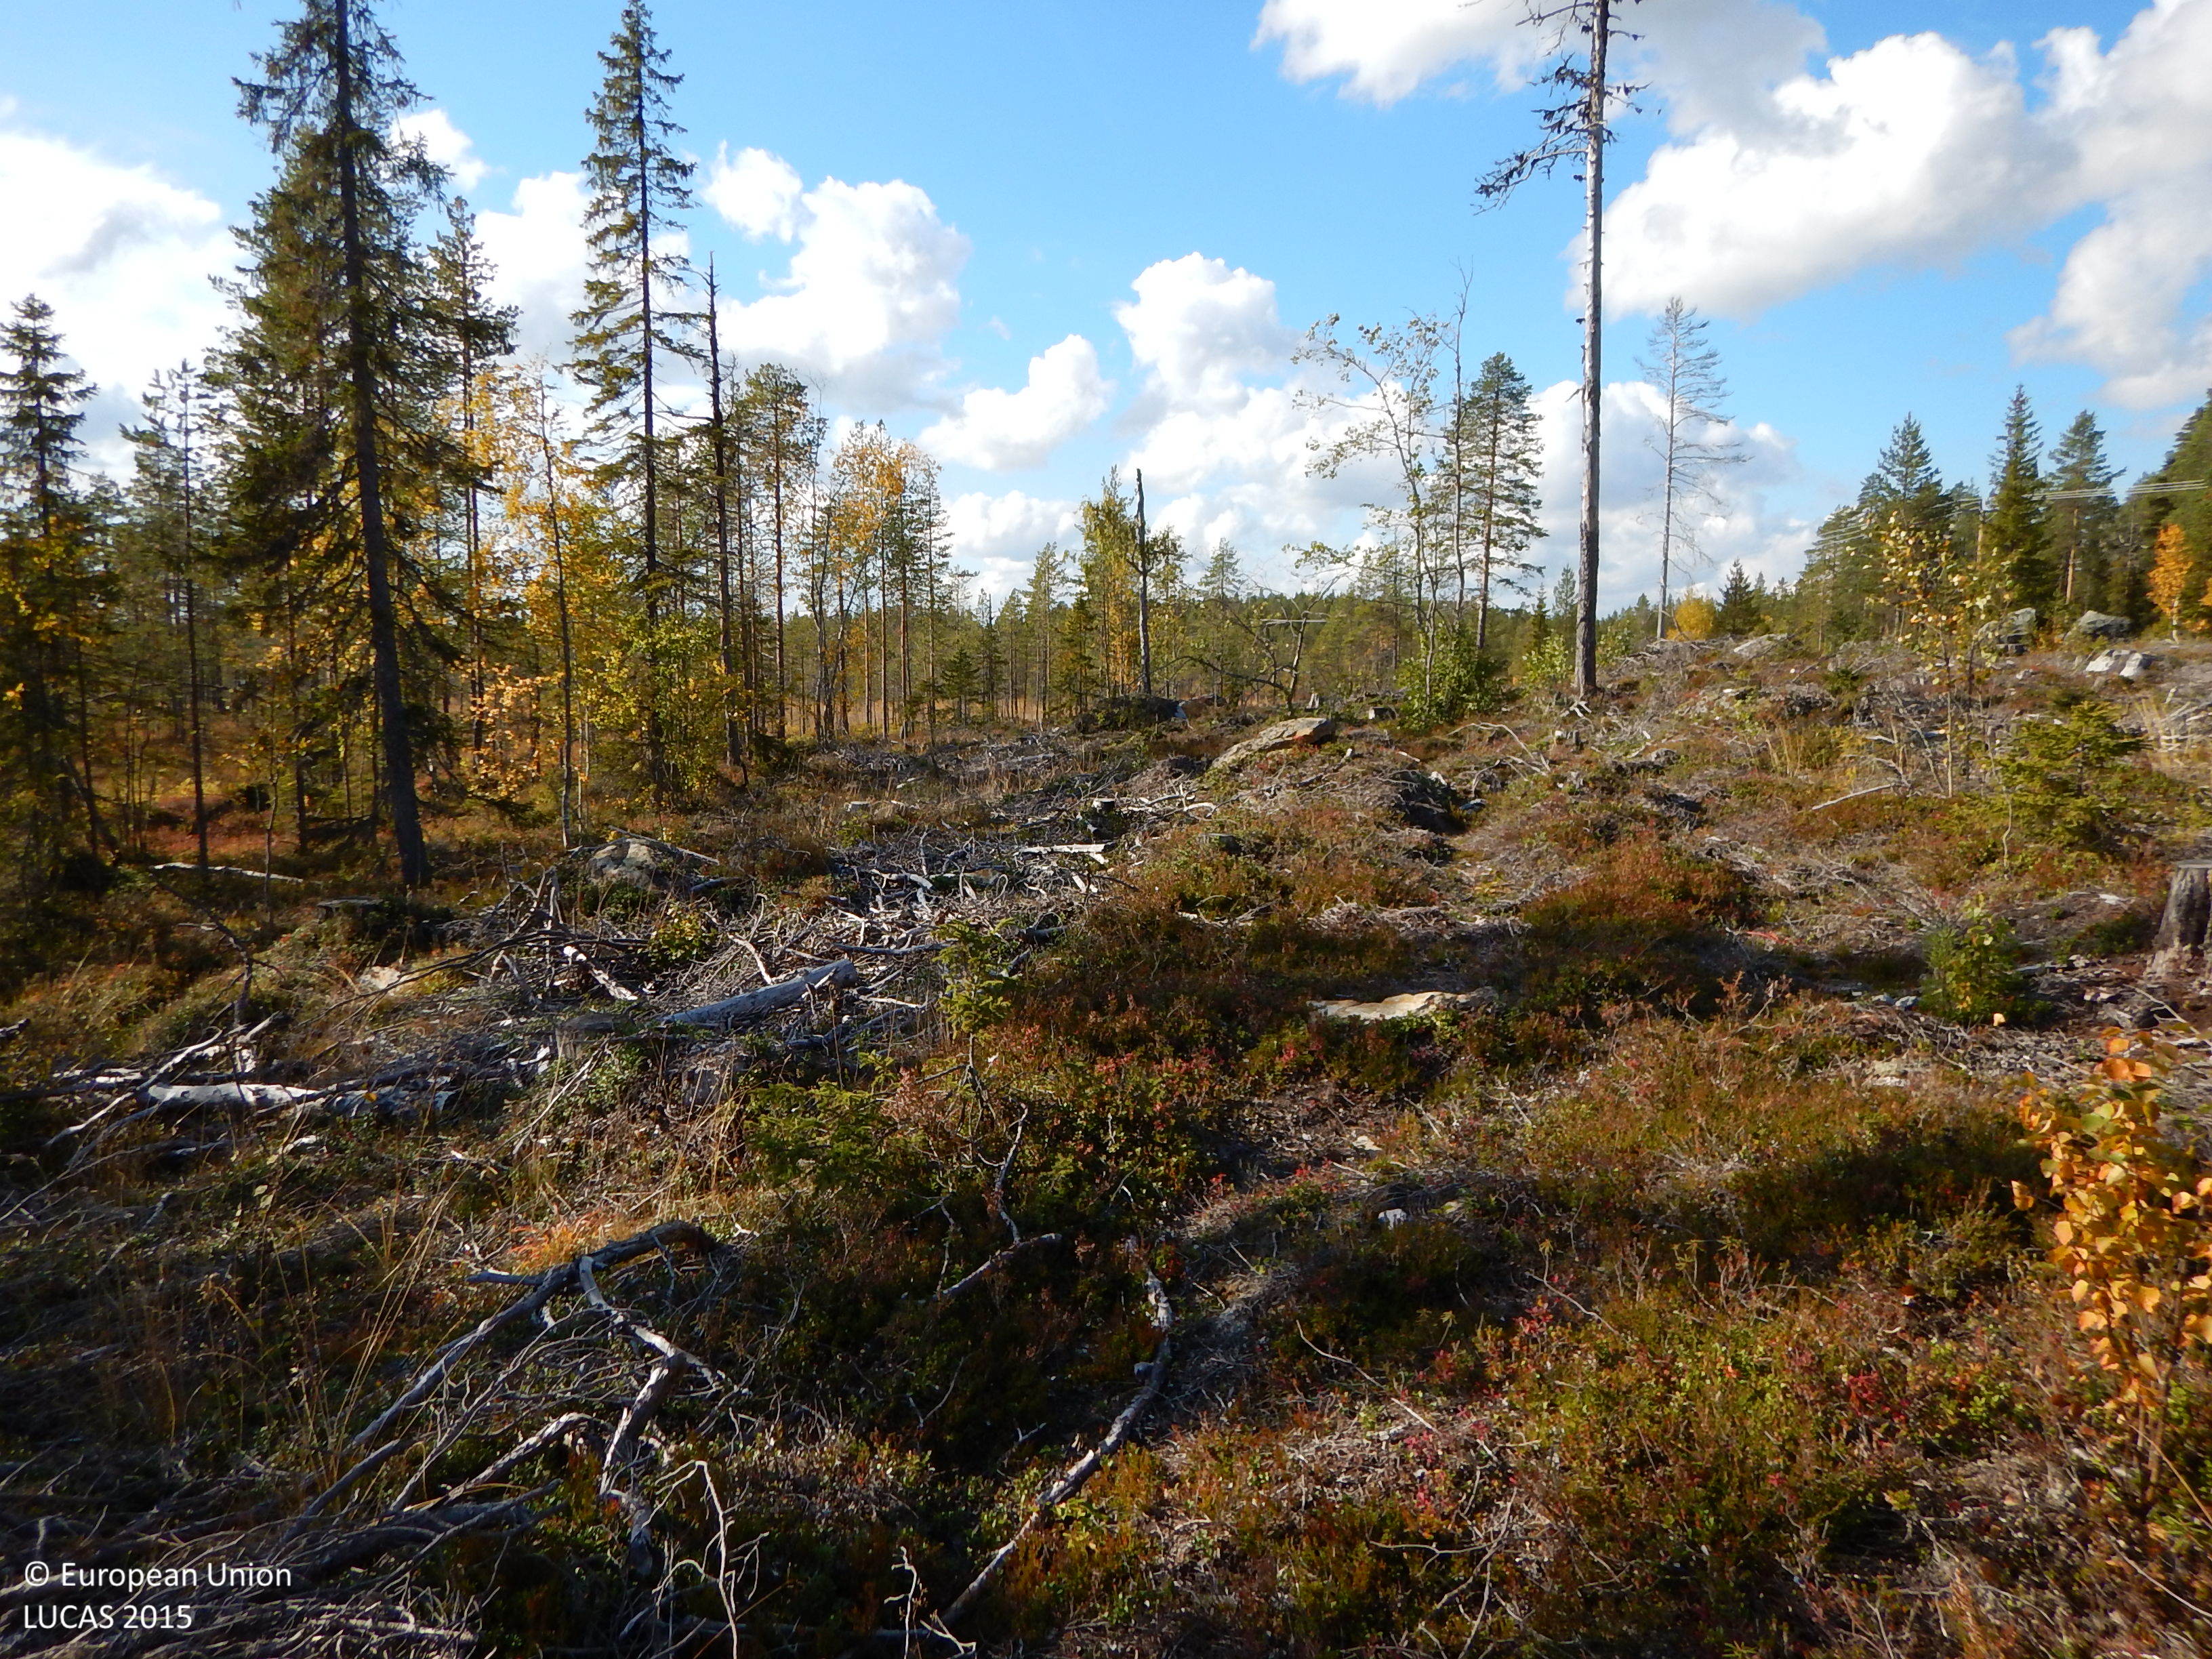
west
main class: Shrubland
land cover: Shrubland with sparse tree cover
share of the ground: 50 - 75 %
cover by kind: shrubs 45 %, unconsolidated bare surface 20 %, herbaceous plants 15 %, lichens and mosses 10 %, coniferous forest trees 5 %, consolidated bare surface 5 %
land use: Forestry
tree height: < 5 m
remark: Clear cut
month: September
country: SE
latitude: 64.7820
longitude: 20.1746
